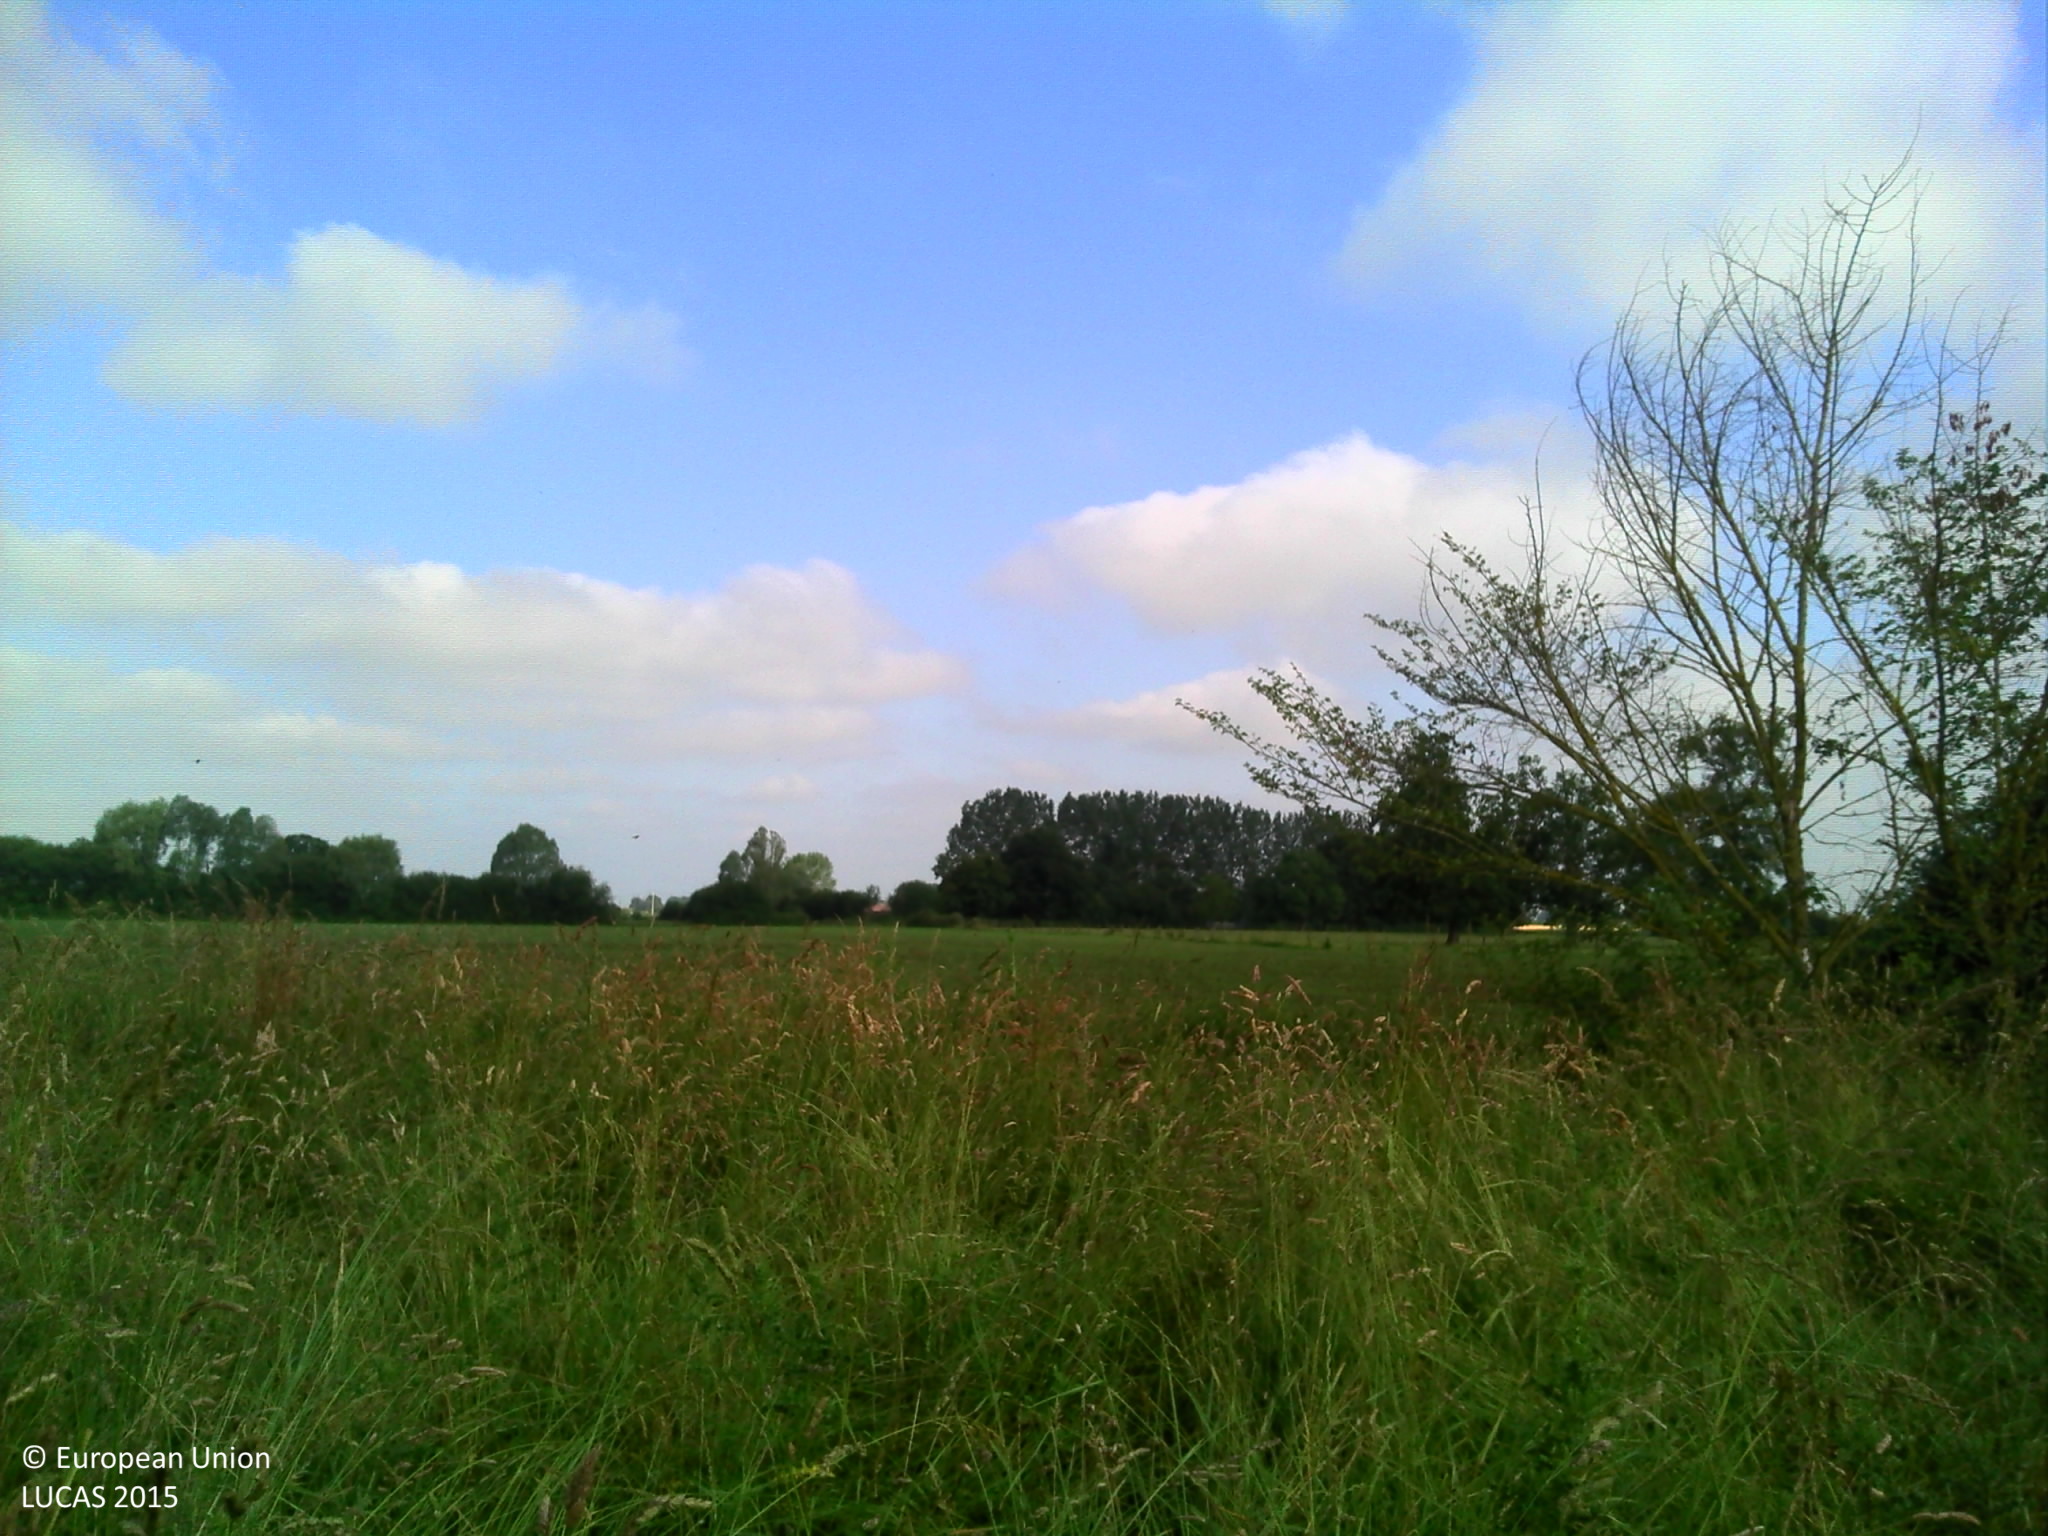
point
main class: Cropland
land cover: Maize
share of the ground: 25 - 50 %
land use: Agriculture (excluding fallow land and kitchen gardens)
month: June
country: FR
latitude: 48.1889
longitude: 0.2482
